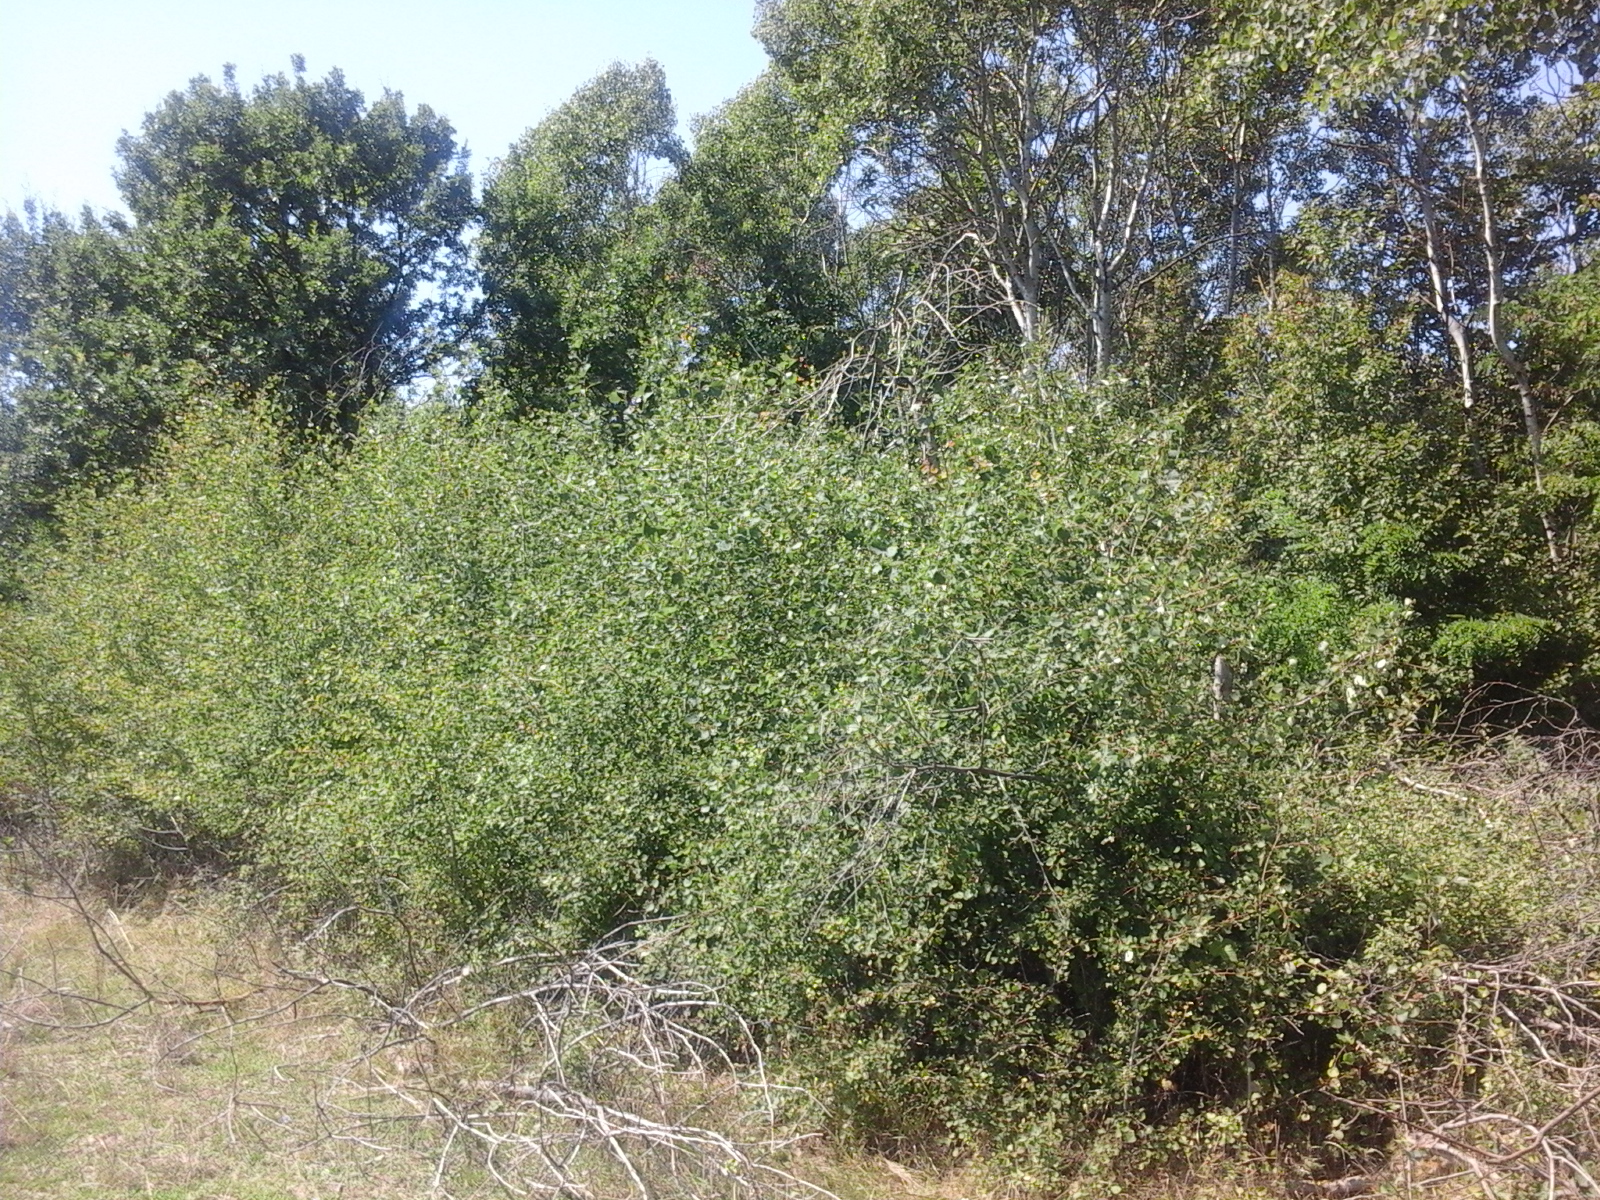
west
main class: Grassland
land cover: Grassland without tree/shrub cover
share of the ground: > 75 %
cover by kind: herbaceous plants 100 %
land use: Agriculture (excluding fallow land and kitchen gardens)
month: August
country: RO
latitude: 45.5988
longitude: 21.6886
